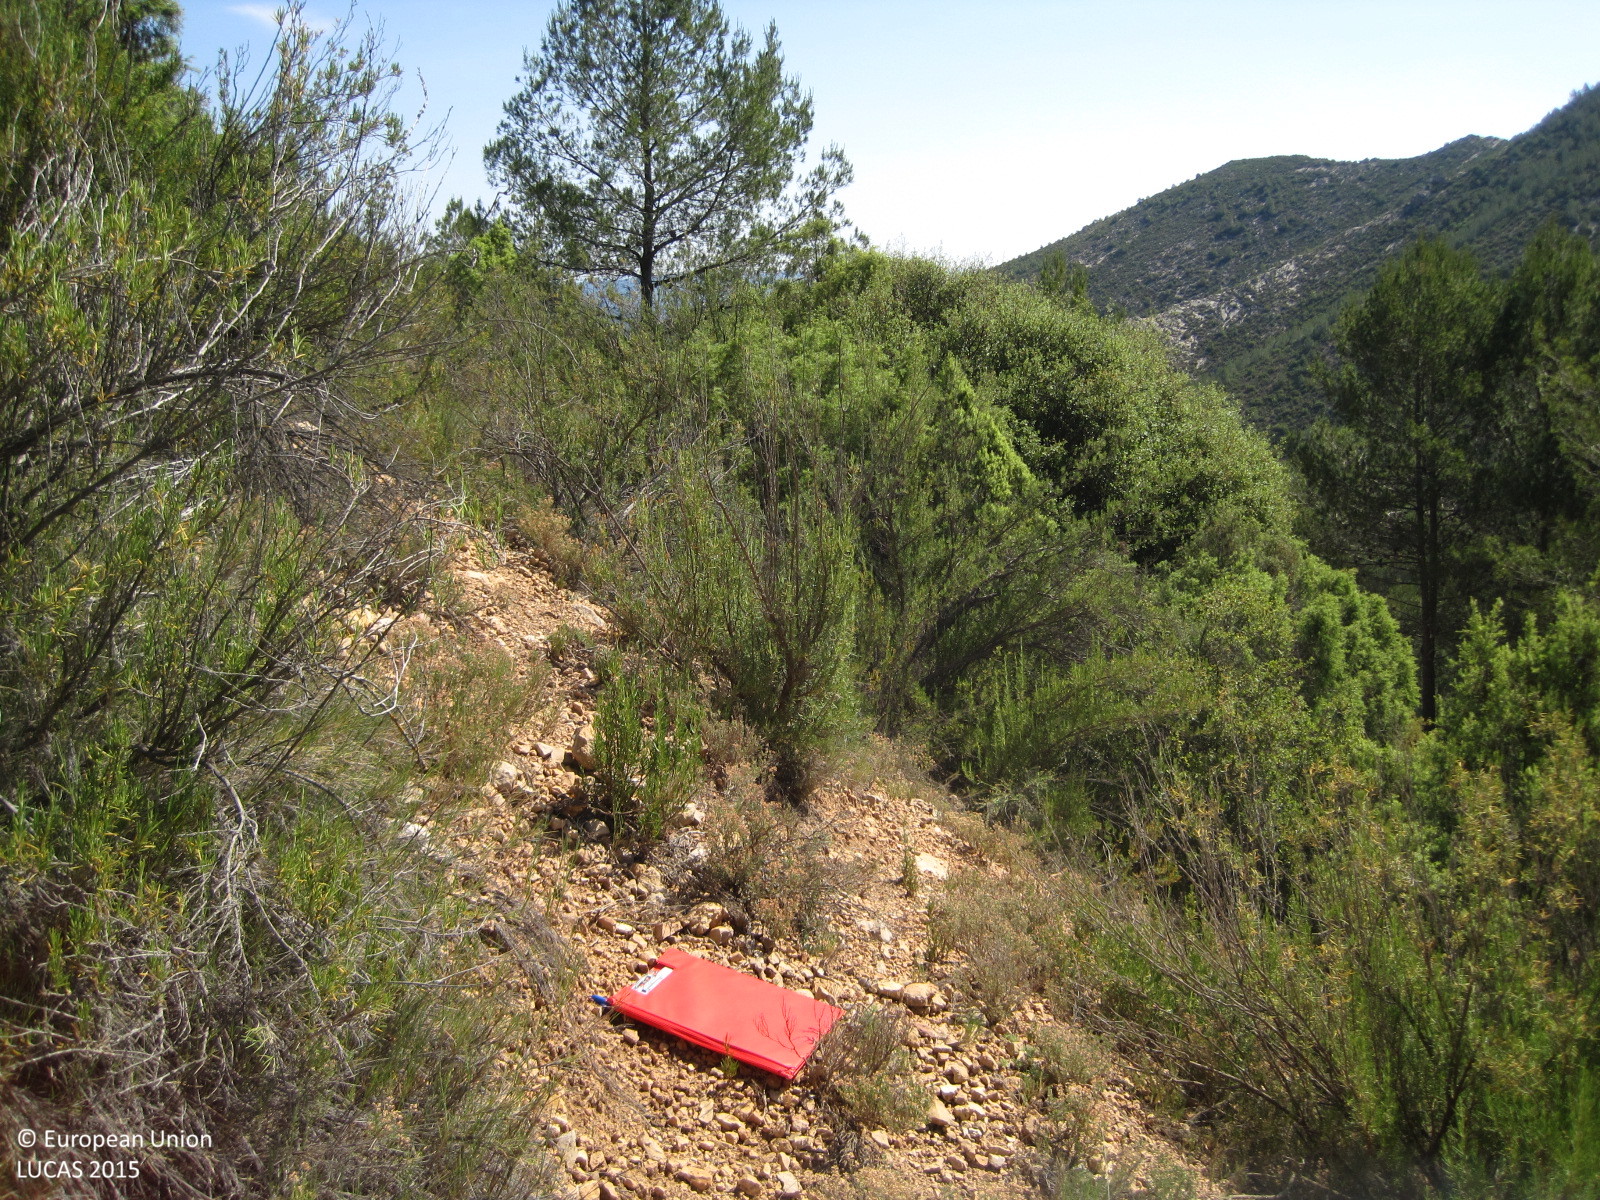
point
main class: Woodland
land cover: Pine dominated coniferous woodland
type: coniferous forest of the mediterranean region
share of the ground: 10 - 25 %
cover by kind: shrubs 50 %, unconsolidated bare surface 20 %, coniferous forest trees 15 %, herbaceous plants 15 %
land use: Forestry
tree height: > 5 m
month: June
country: ES
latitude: 39.7394
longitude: -1.1483
